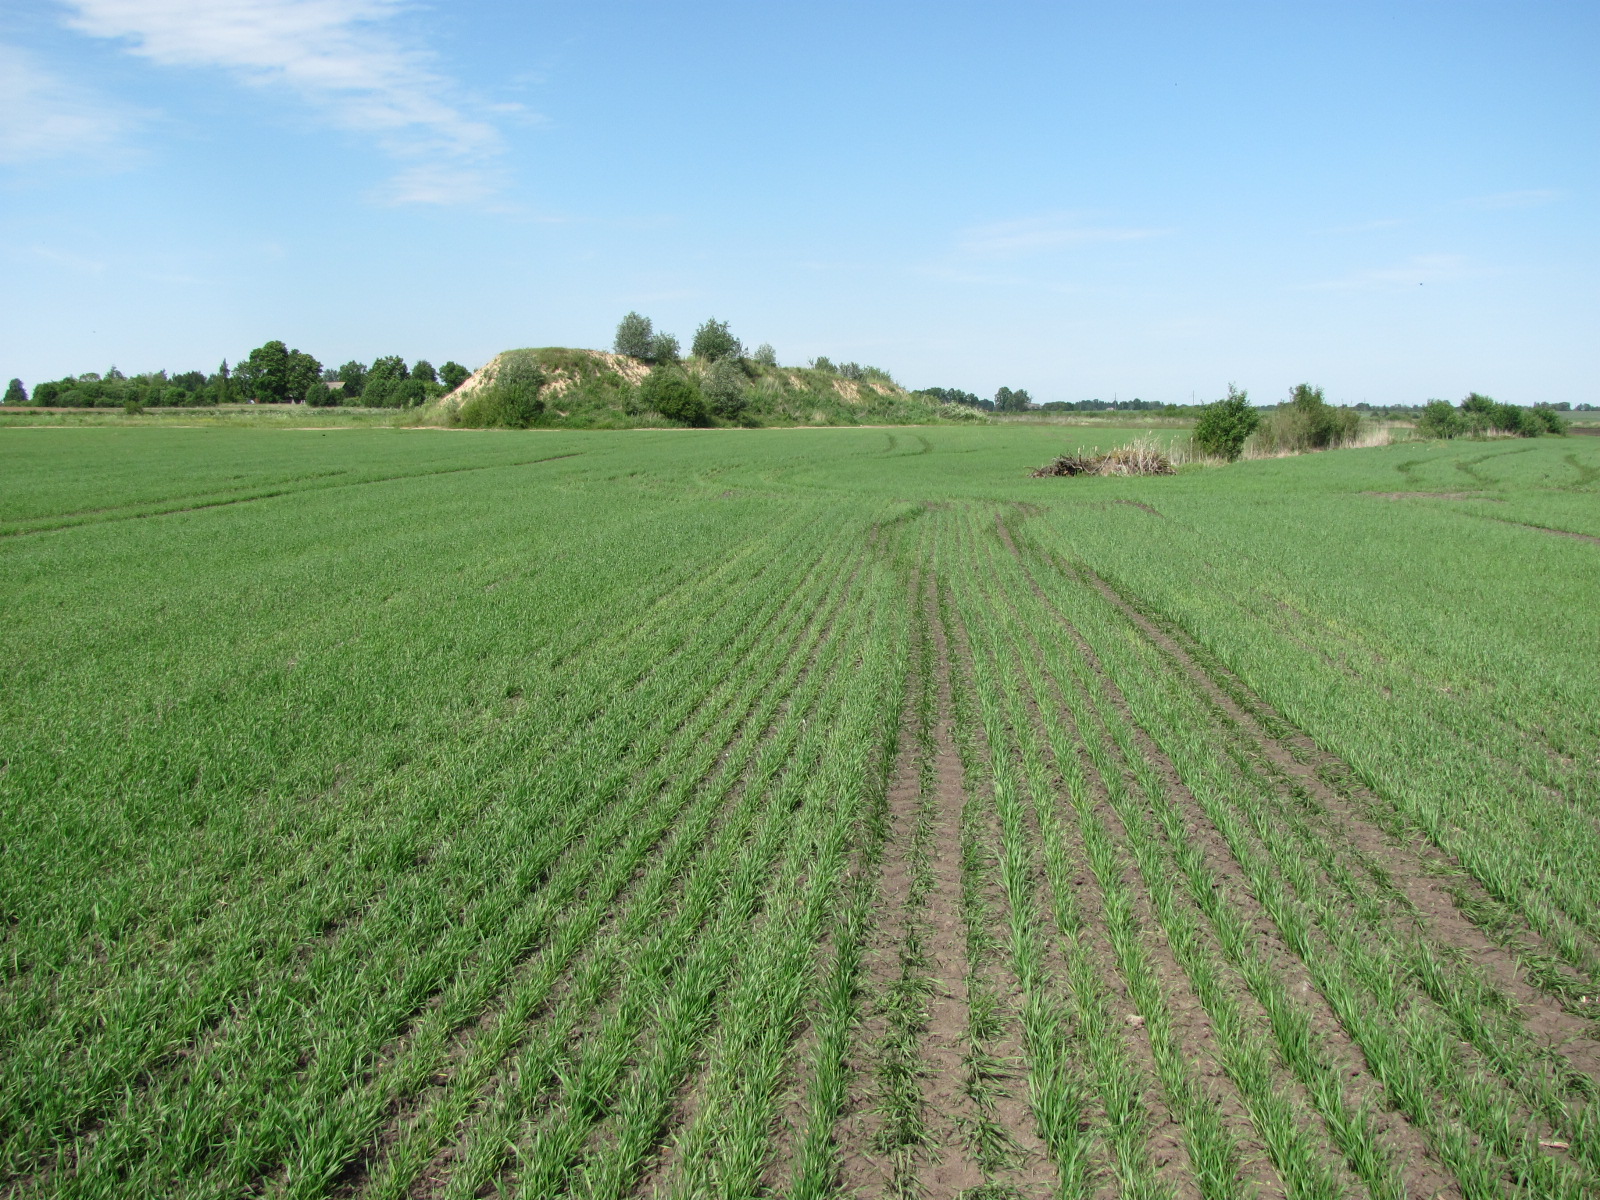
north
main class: Cropland
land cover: Common wheat
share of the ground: > 75 %
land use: Agriculture (excluding fallow land and kitchen gardens)
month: June
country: LV
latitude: 56.4930
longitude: 24.3369
